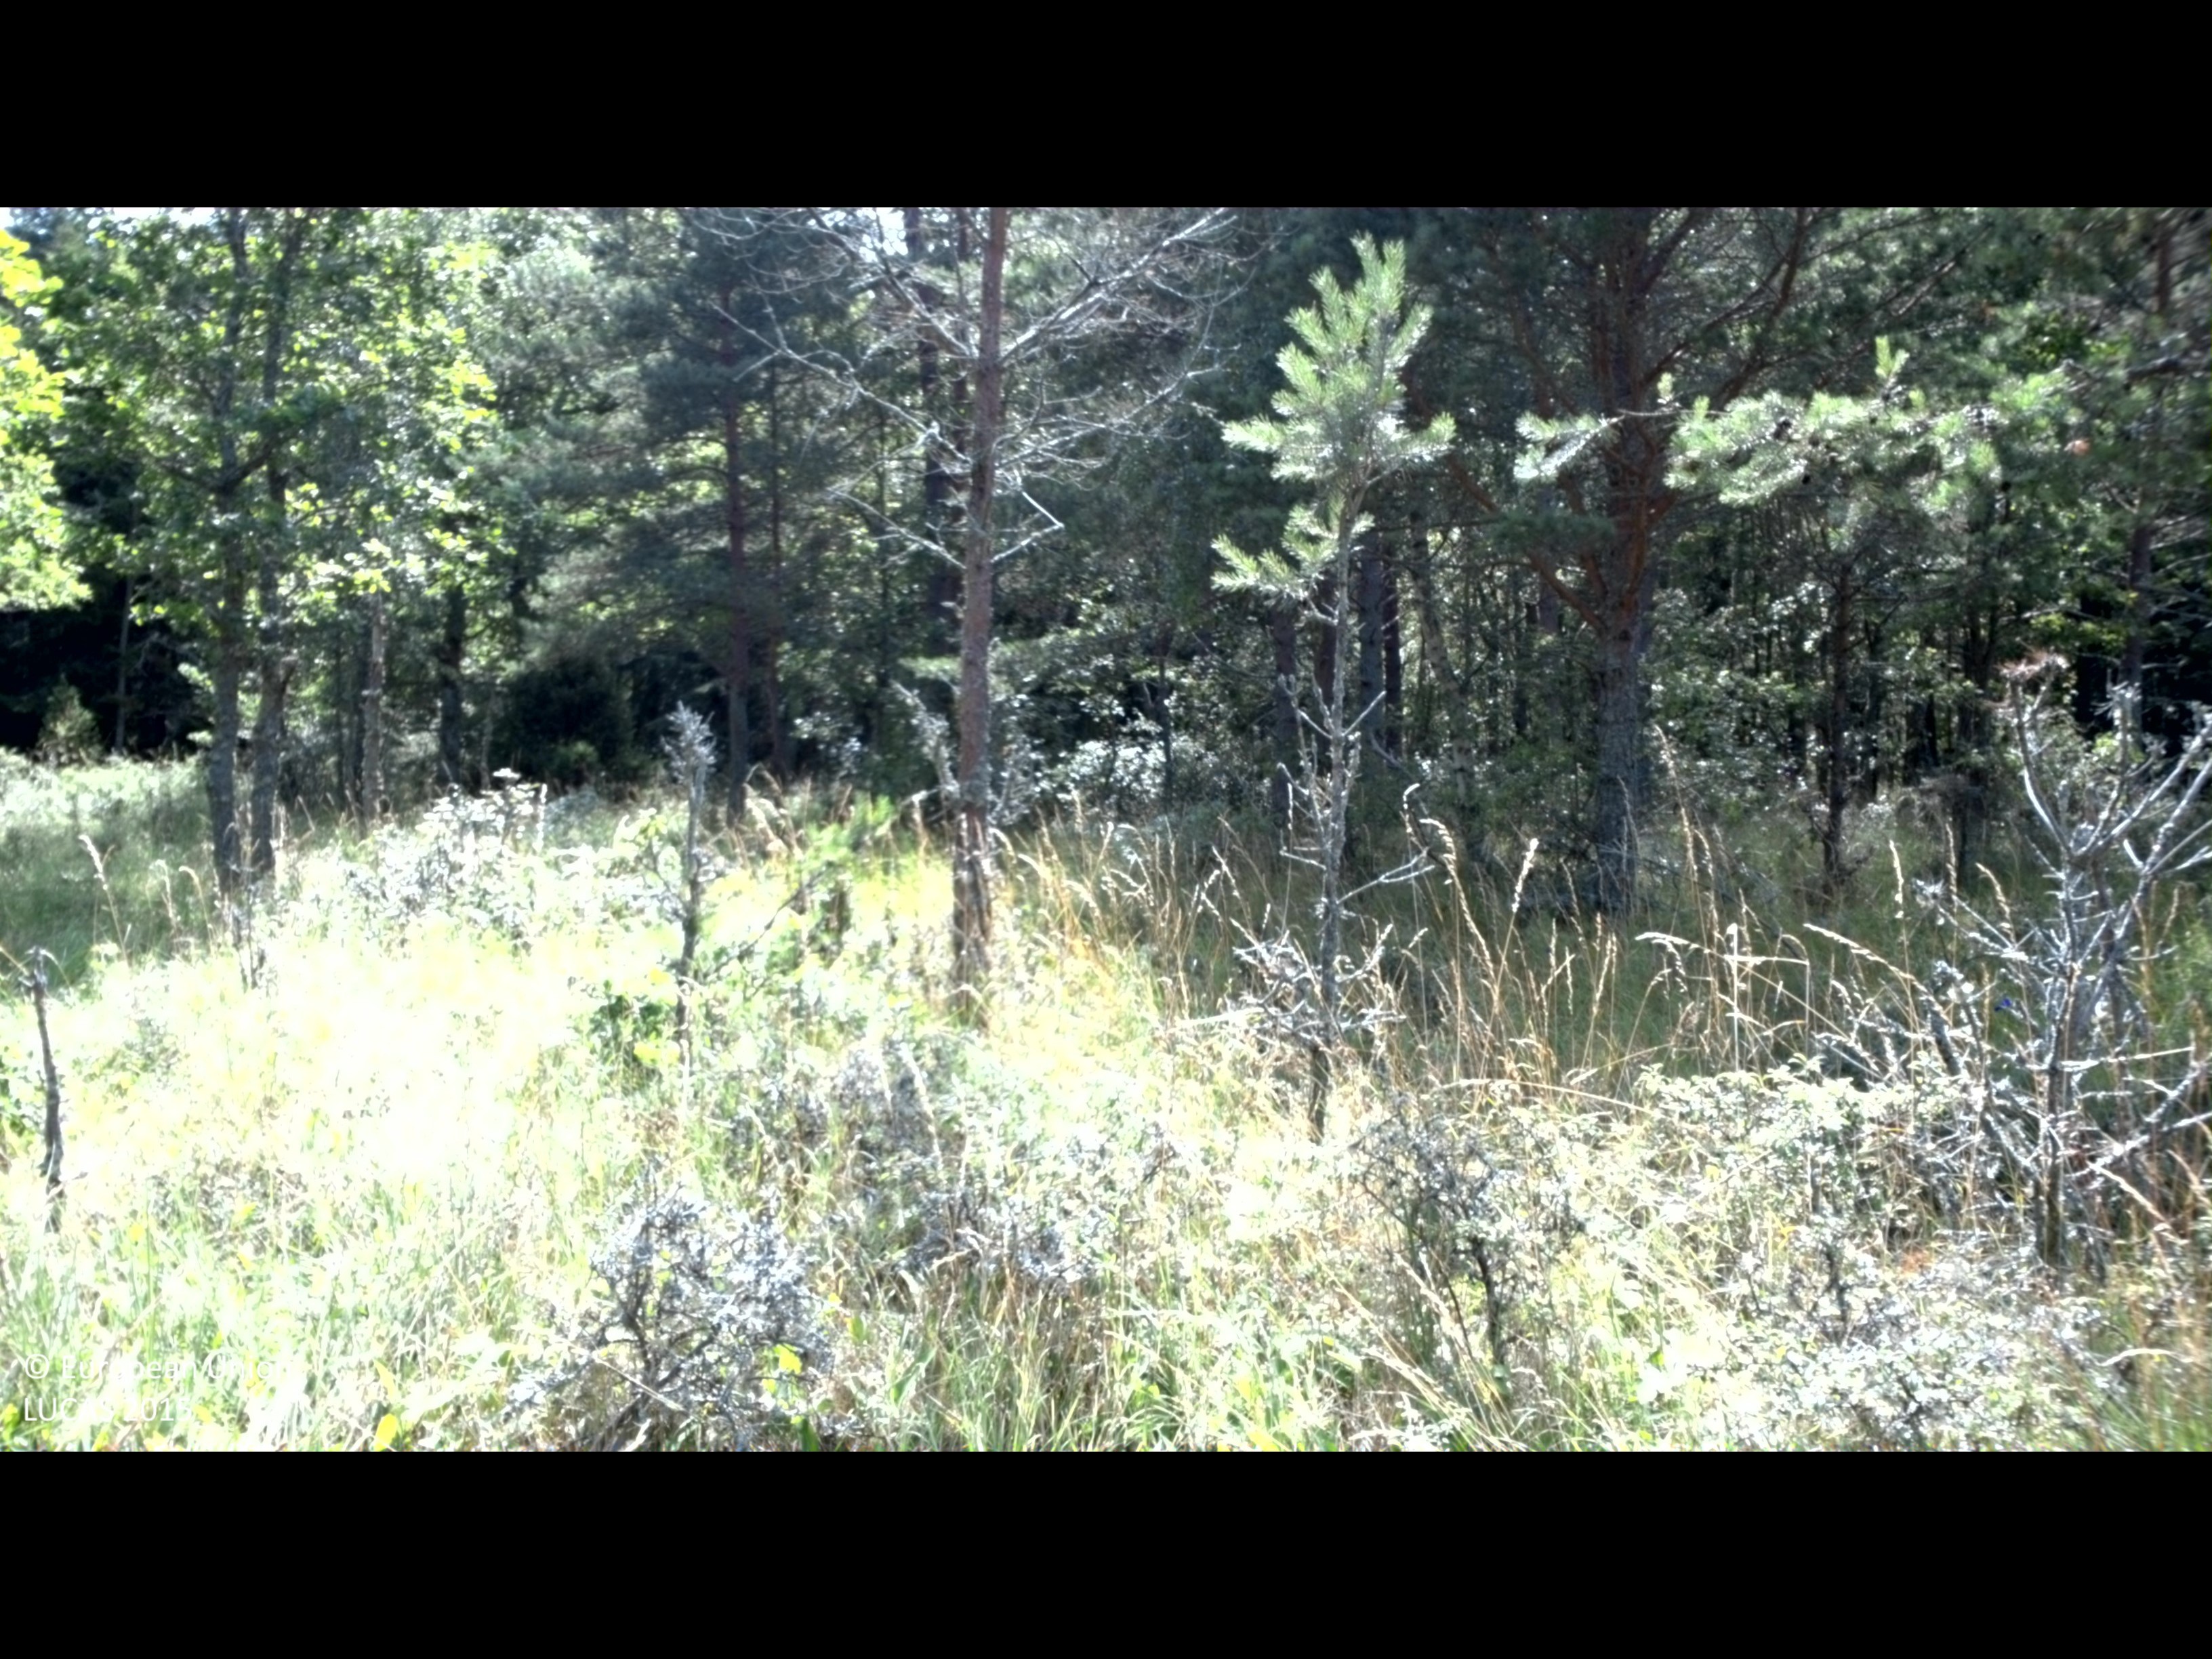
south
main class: Shrubland
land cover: Shrubland with sparse tree cover
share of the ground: 10 - 25 %
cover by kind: herbaceous plants 75 %, shrubs 20 %, coniferous forest trees 5 %
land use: Amenities, museums, leisure
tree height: < 5 m
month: July
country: SE
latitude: 57.3473
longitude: 17.0642
